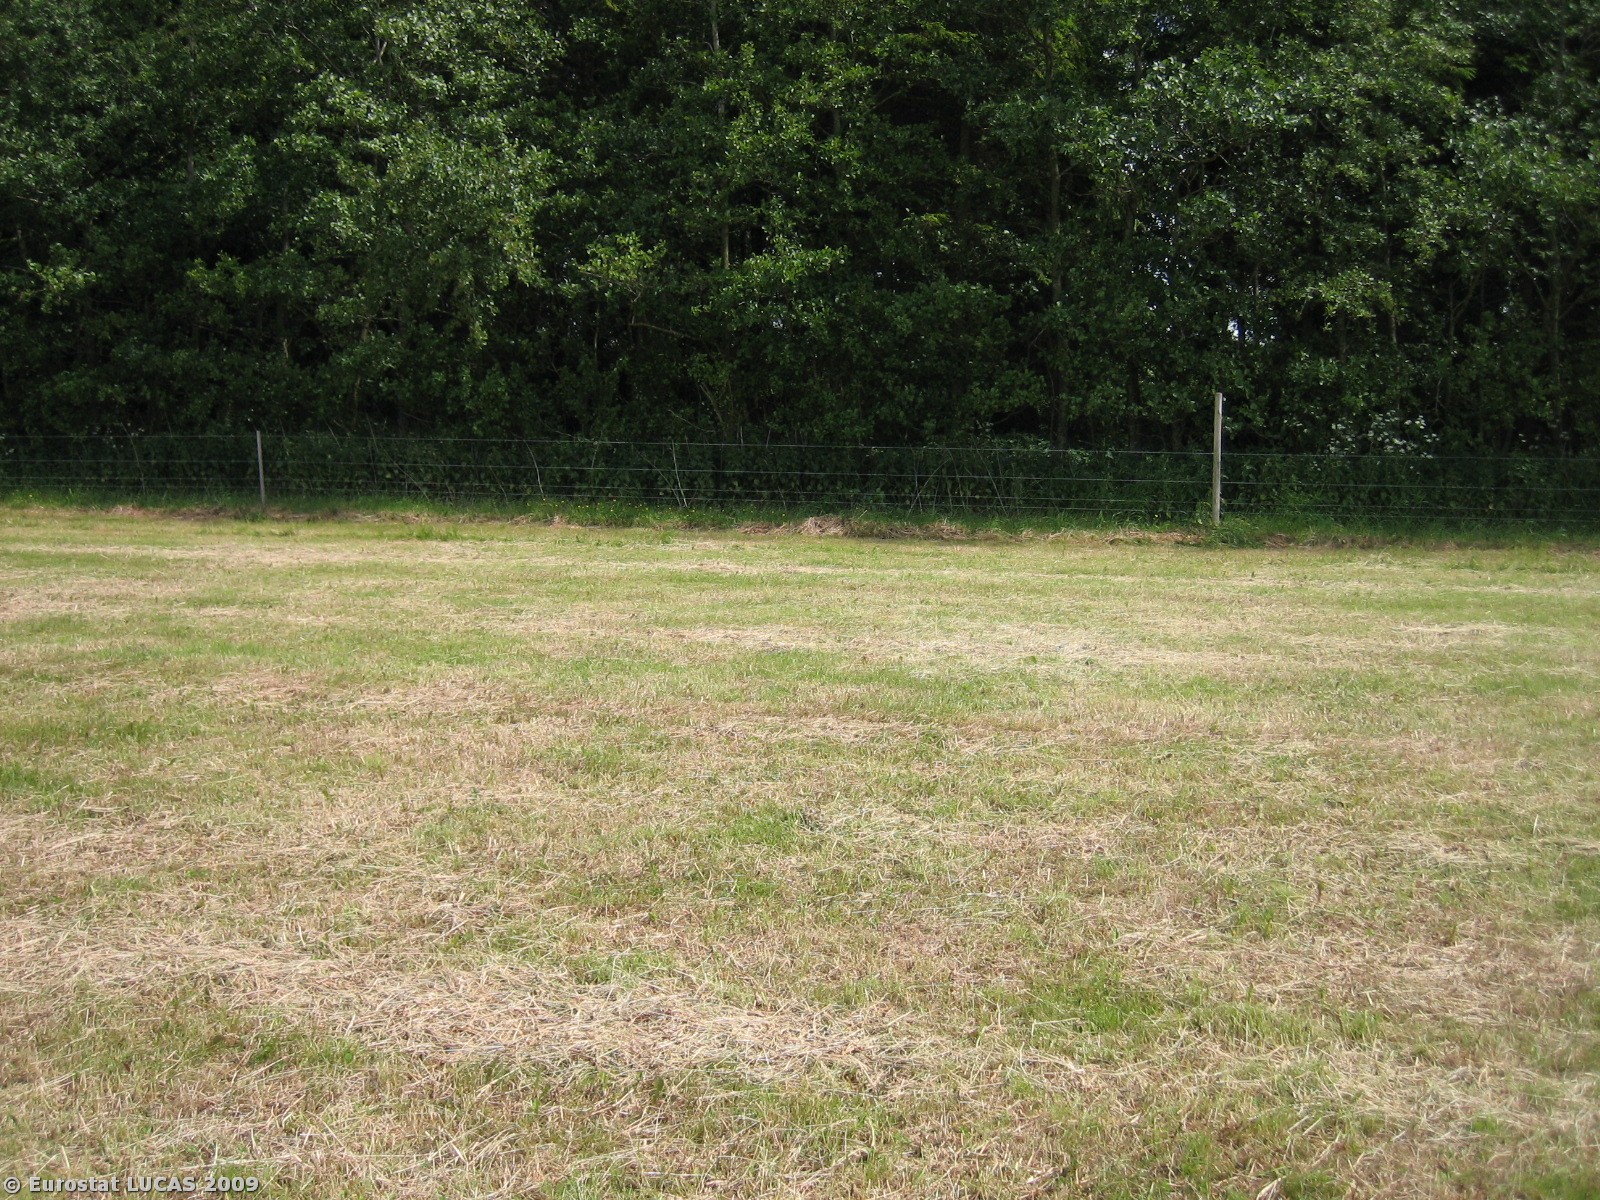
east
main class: Grassland
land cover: Grassland without tree/shrub cover
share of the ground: > 75 %
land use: Agriculture (excluding fallow land and kitchen gardens)
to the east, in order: Grassland without tree/shrub cover; Fences; Coniferous woodland; Broadleaved woodland; Grassland without tree/shrub cover; Tracks; Grassland without tree/shrub cover; Broadleaved woodland; Fences; Grassland without tree/shrub cover; Fences; Grassland with sparse tree/shrub cover; Fences; Coniferous woodland
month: June
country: DK
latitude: 56.2593
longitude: 9.7259
